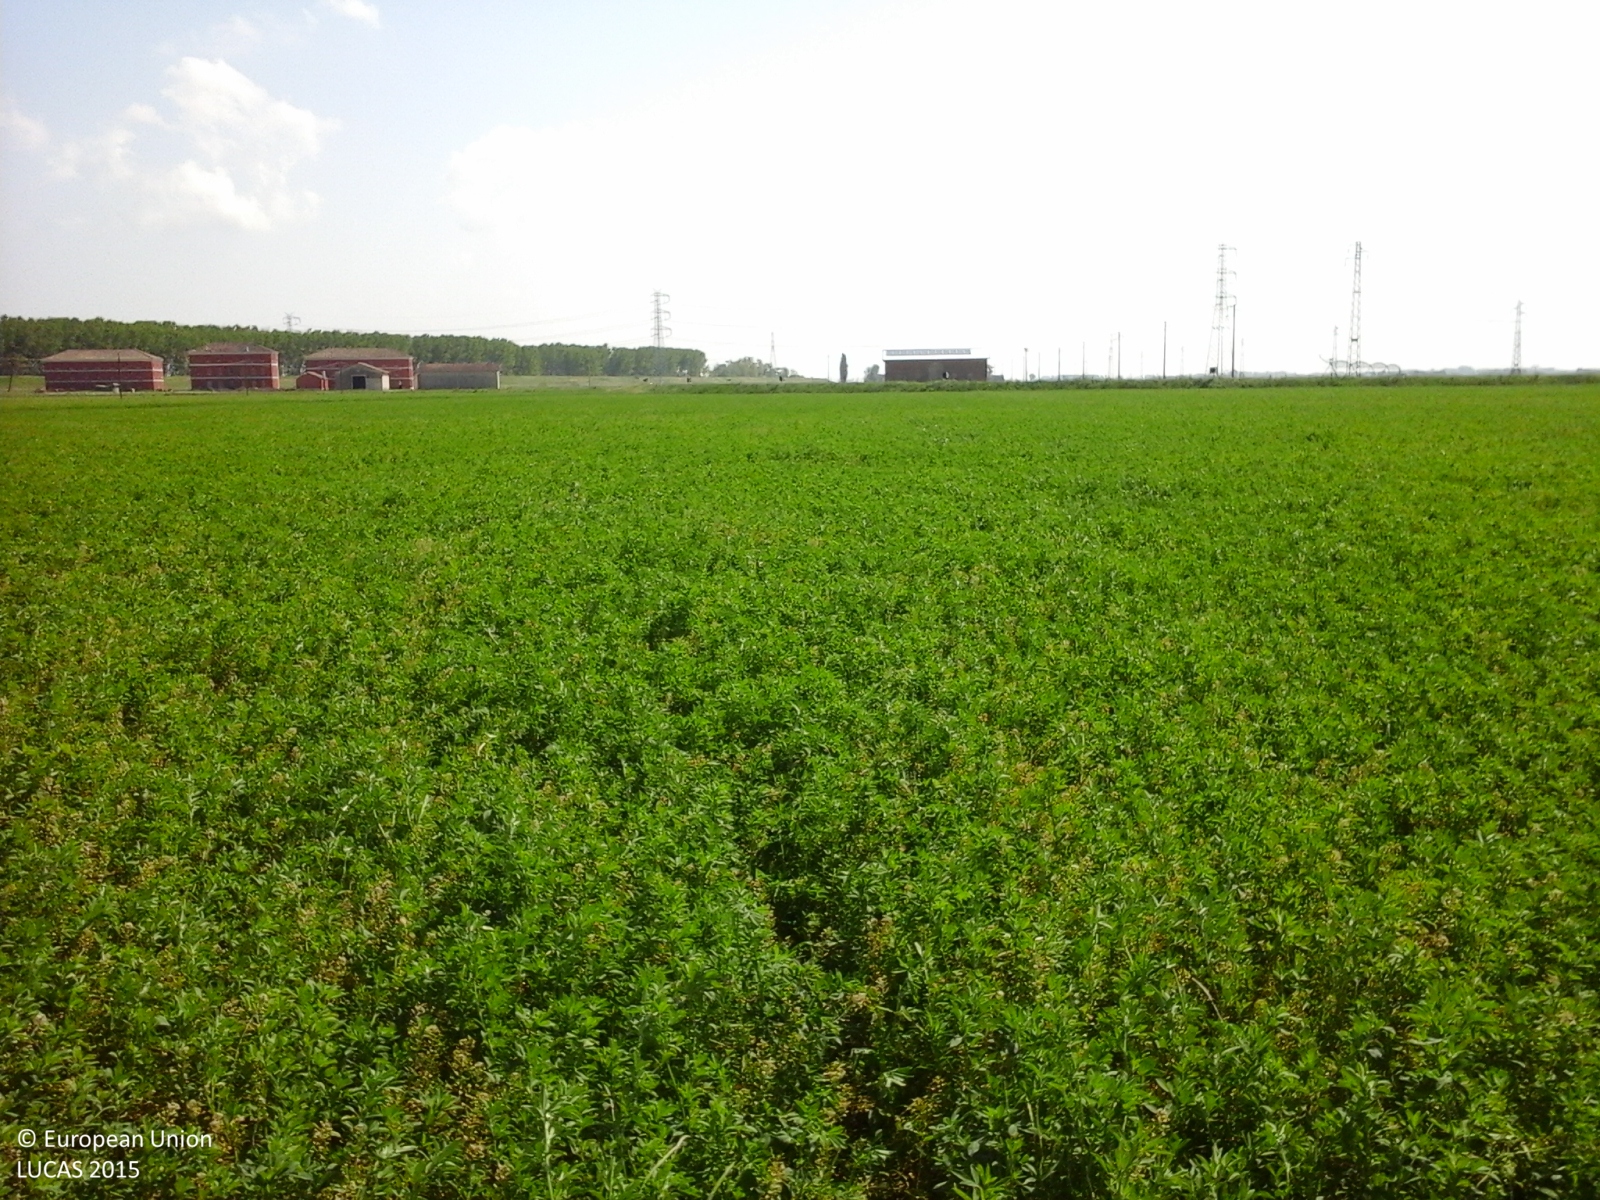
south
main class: Cropland
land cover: Lucerne
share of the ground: > 75 %
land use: Agriculture (excluding fallow land and kitchen gardens)
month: April
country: IT
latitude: 44.9201
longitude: 12.3140
